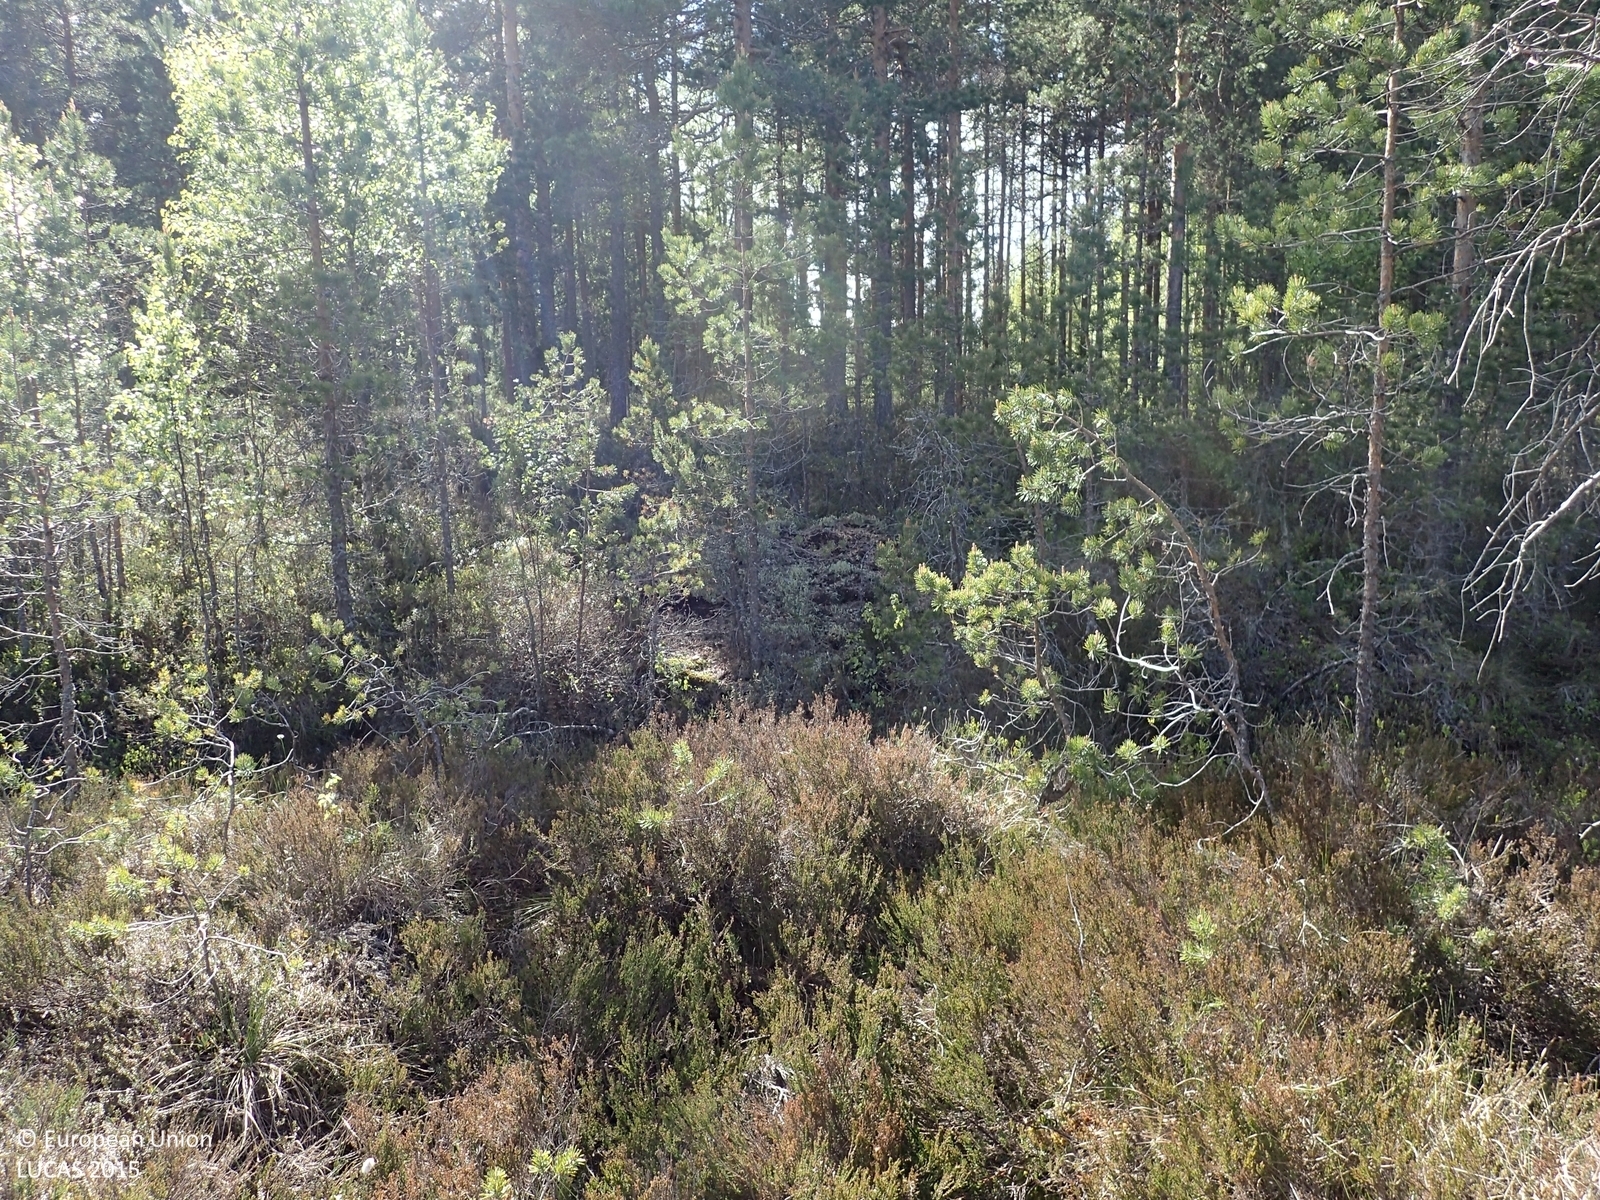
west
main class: Woodland
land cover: Pine dominated coniferous woodland
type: mire and swamp forests
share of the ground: 50 - 75 %
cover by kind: coniferous forest trees 50 %, shrubs 50 %
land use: Semi-natural and natural areas not in use
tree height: > 5 m
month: June
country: FI
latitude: 62.2729
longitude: 21.8204
